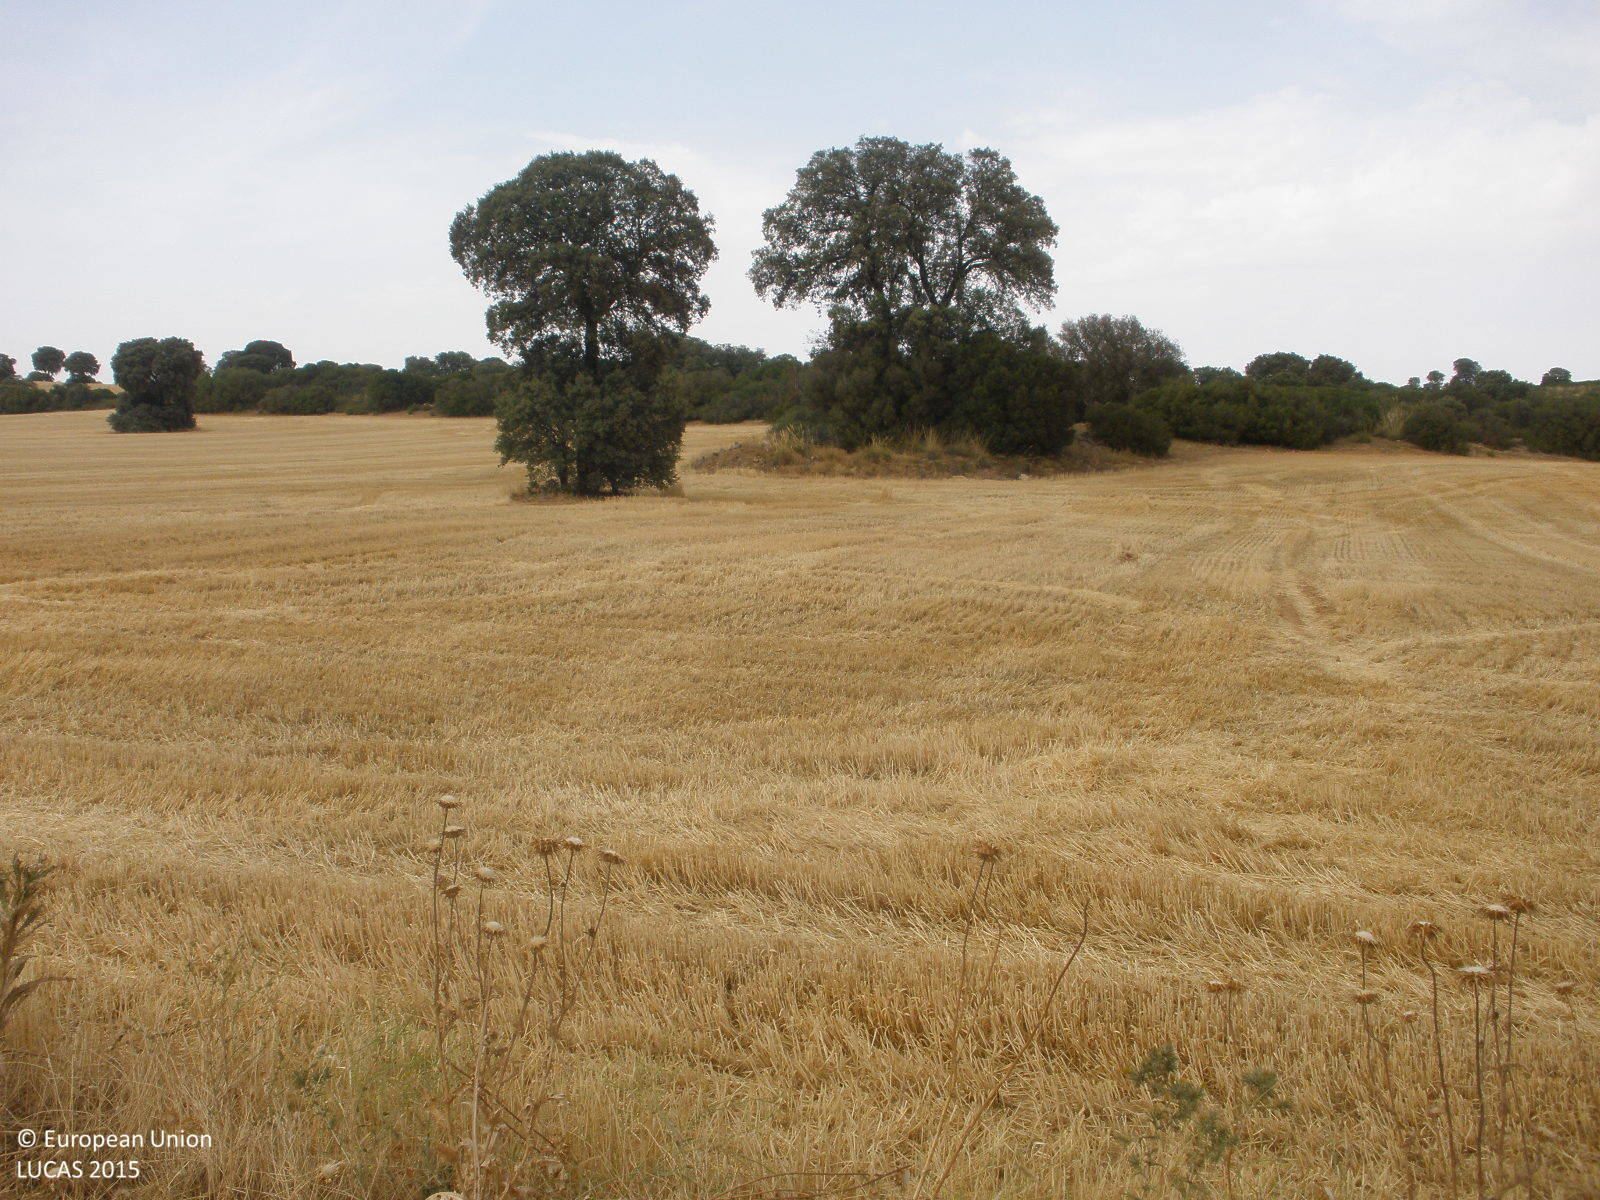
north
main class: Cropland
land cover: Oats
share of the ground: > 75 %
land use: Agriculture (excluding fallow land and kitchen gardens)
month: July
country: ES
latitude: 39.8079
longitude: -3.3527
